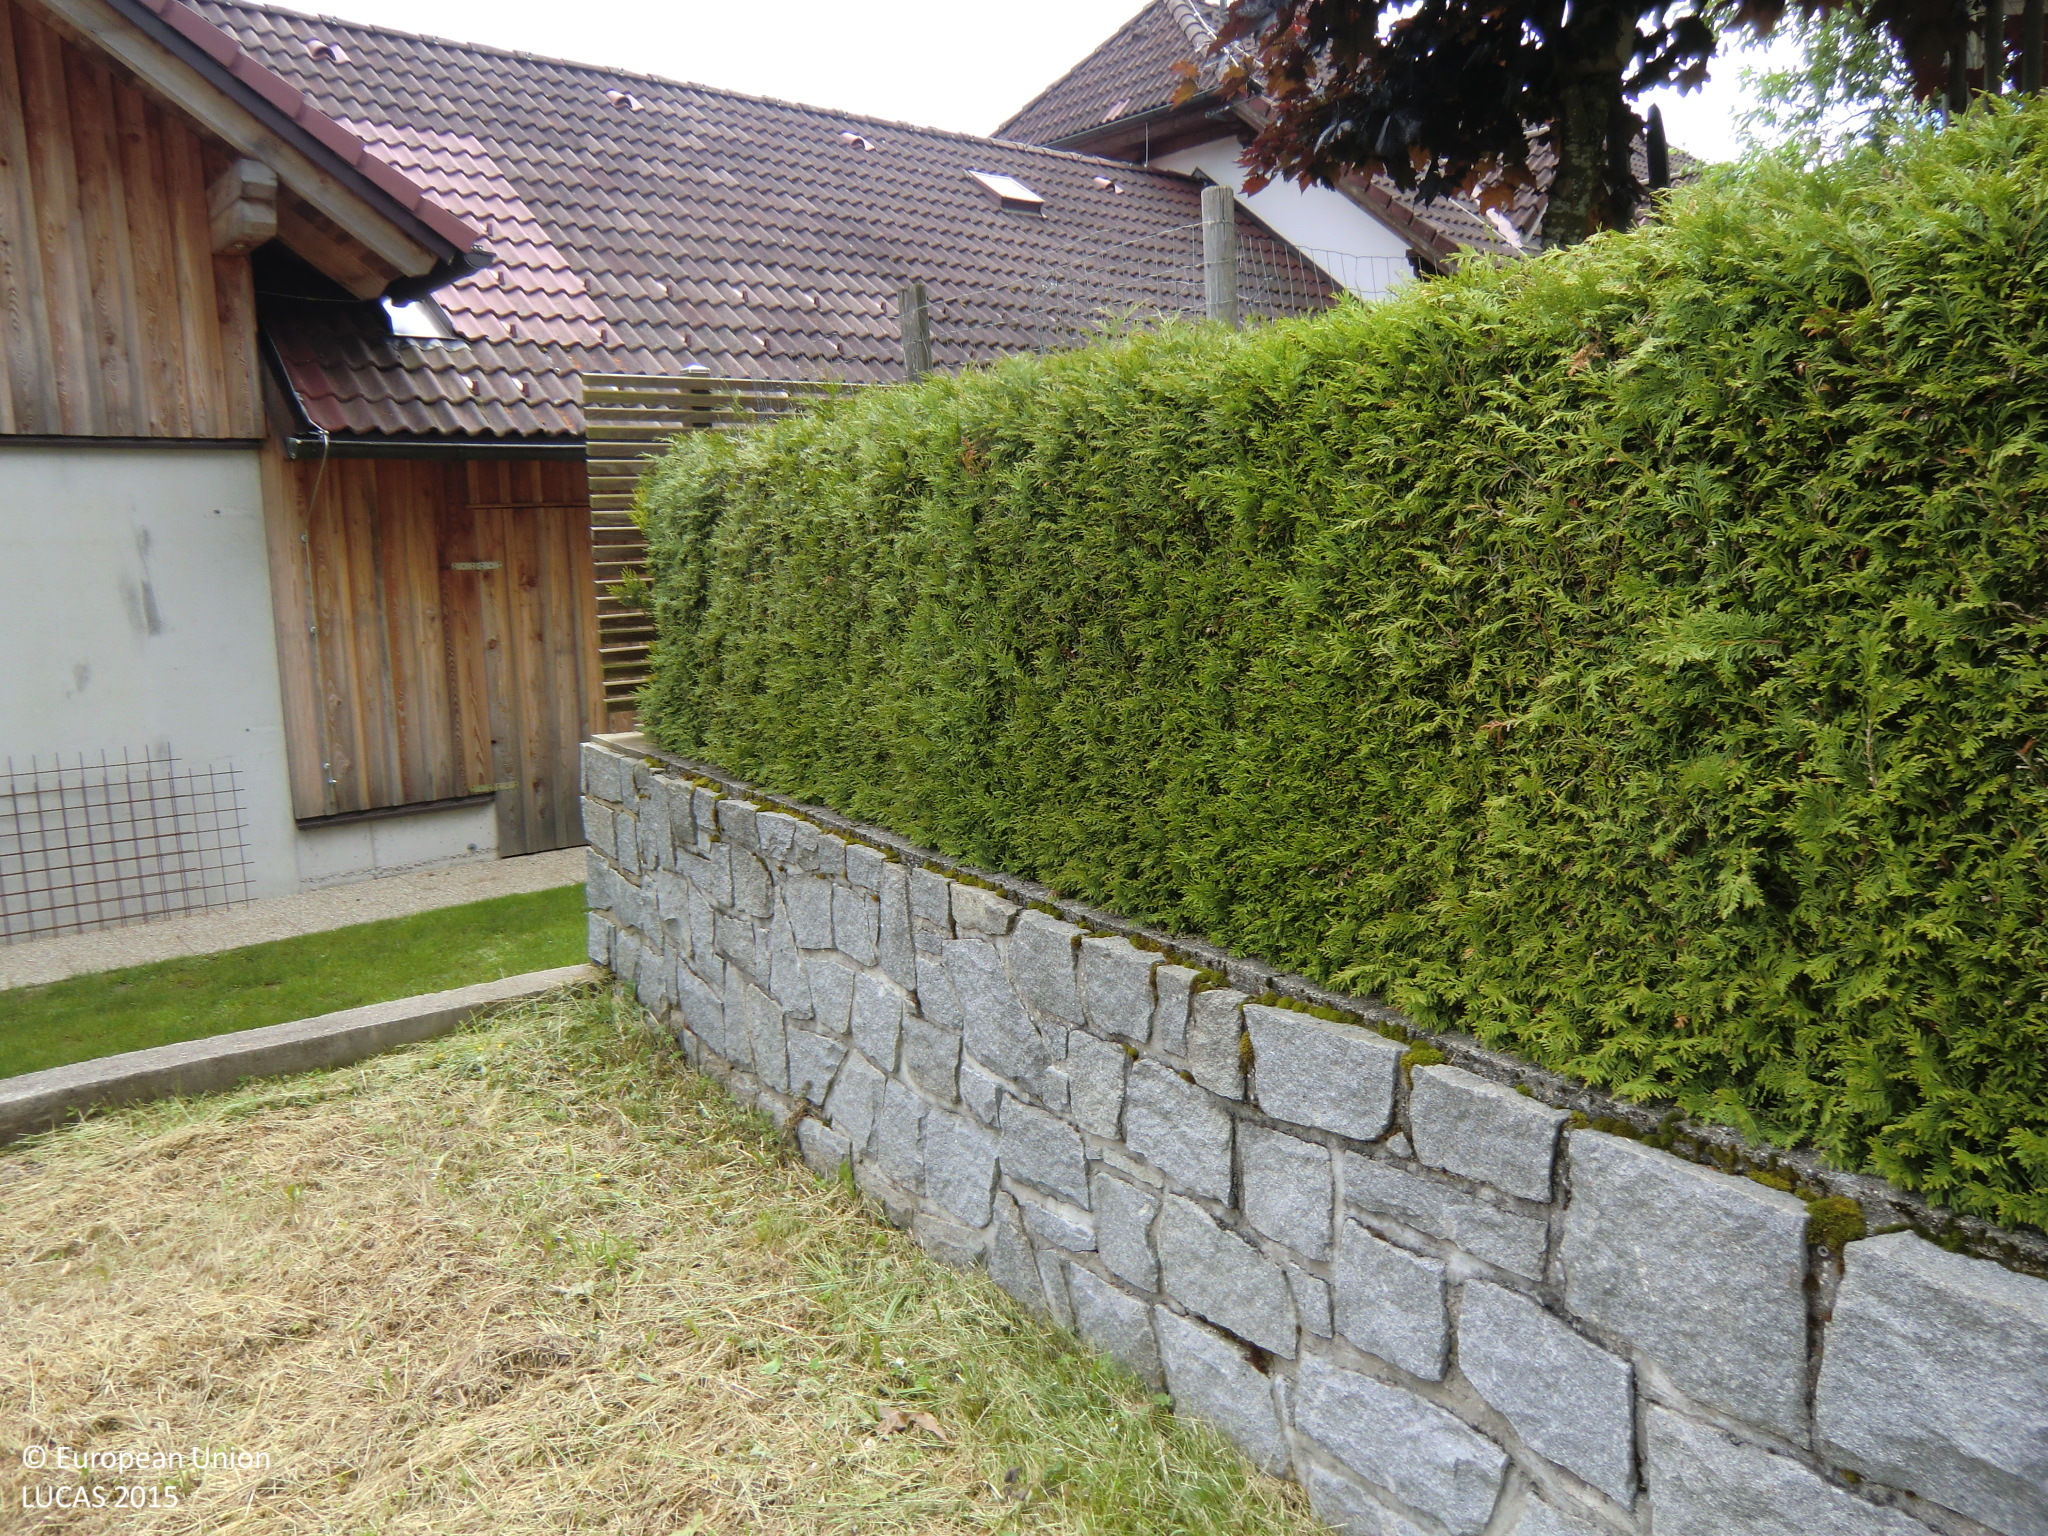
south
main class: Woodland
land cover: Broadleaved woodland
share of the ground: > 75 %
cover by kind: herbaceous plants 80 %, broadleaved forest trees 15 %, coniferous forest trees 5 %
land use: Residential
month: June
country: AT
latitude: 48.5581
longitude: 14.6484
